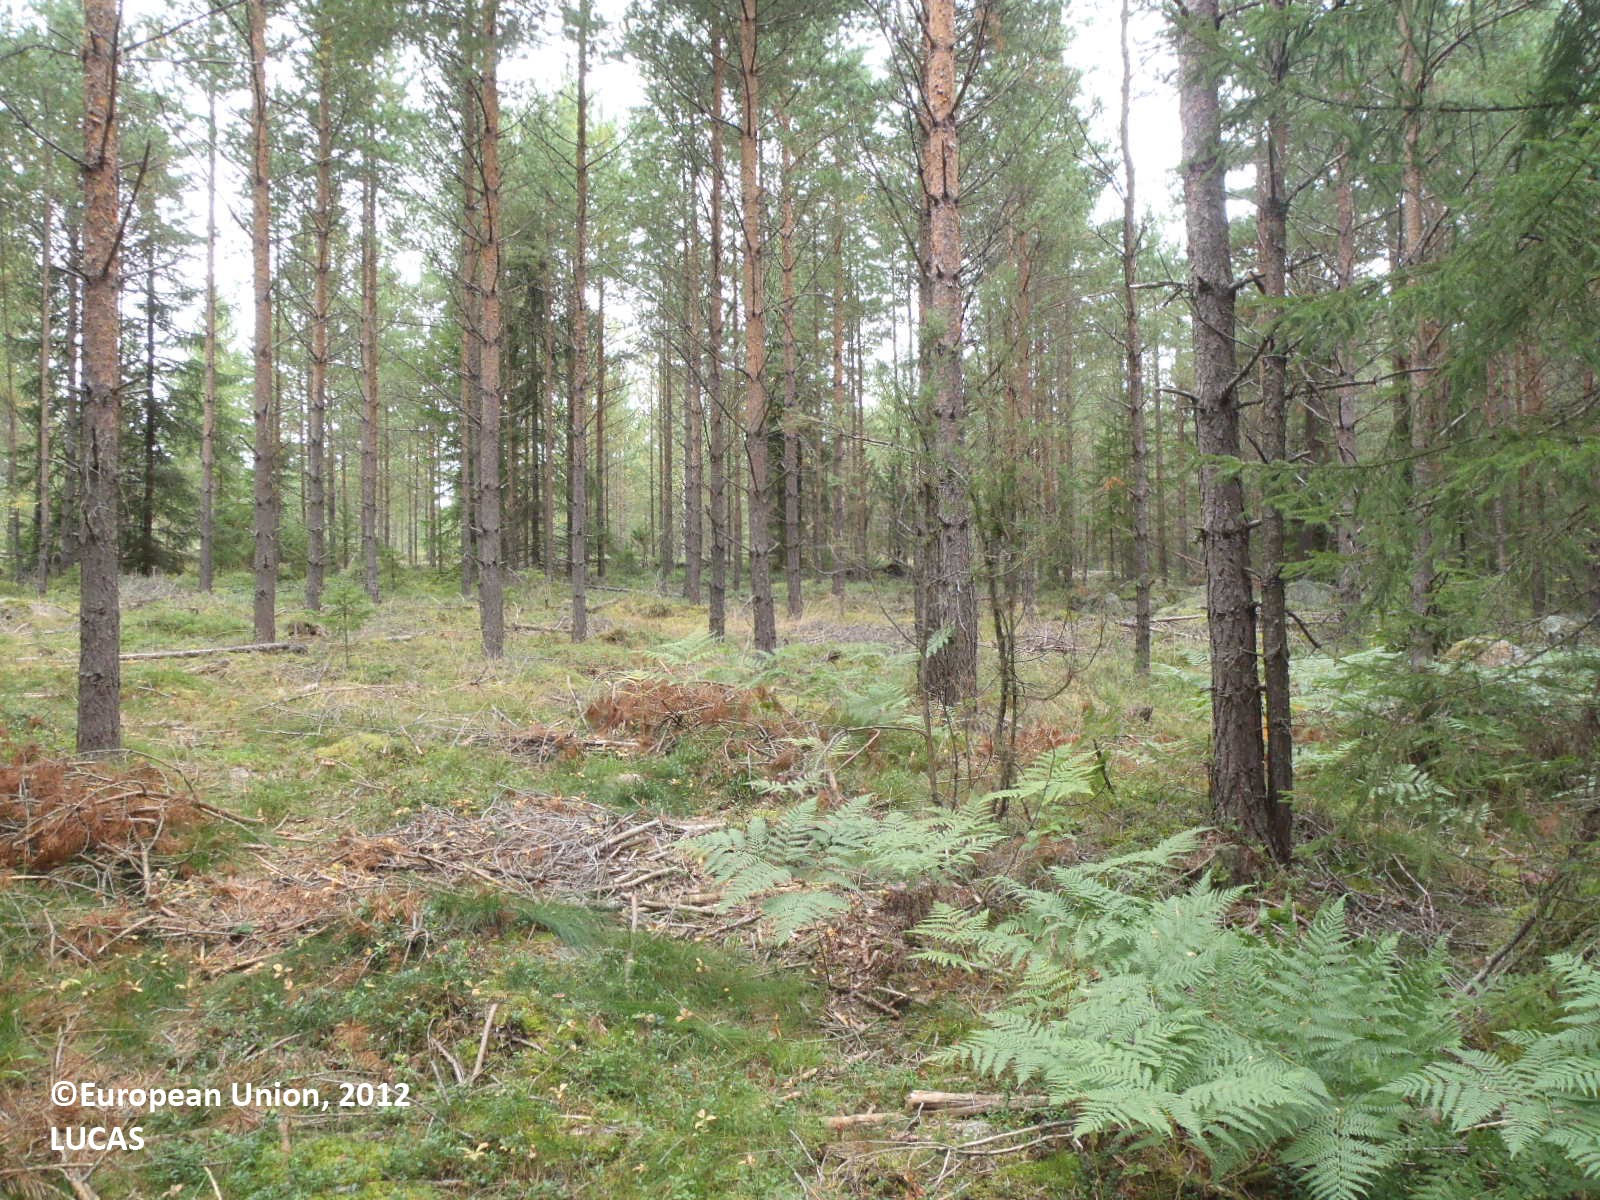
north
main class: Woodland
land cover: Pine dominated coniferous woodland
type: boreal forest
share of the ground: 50 - 75 %
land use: Forestry
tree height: > 5 m
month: September
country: FI
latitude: 60.9800
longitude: 22.8414
